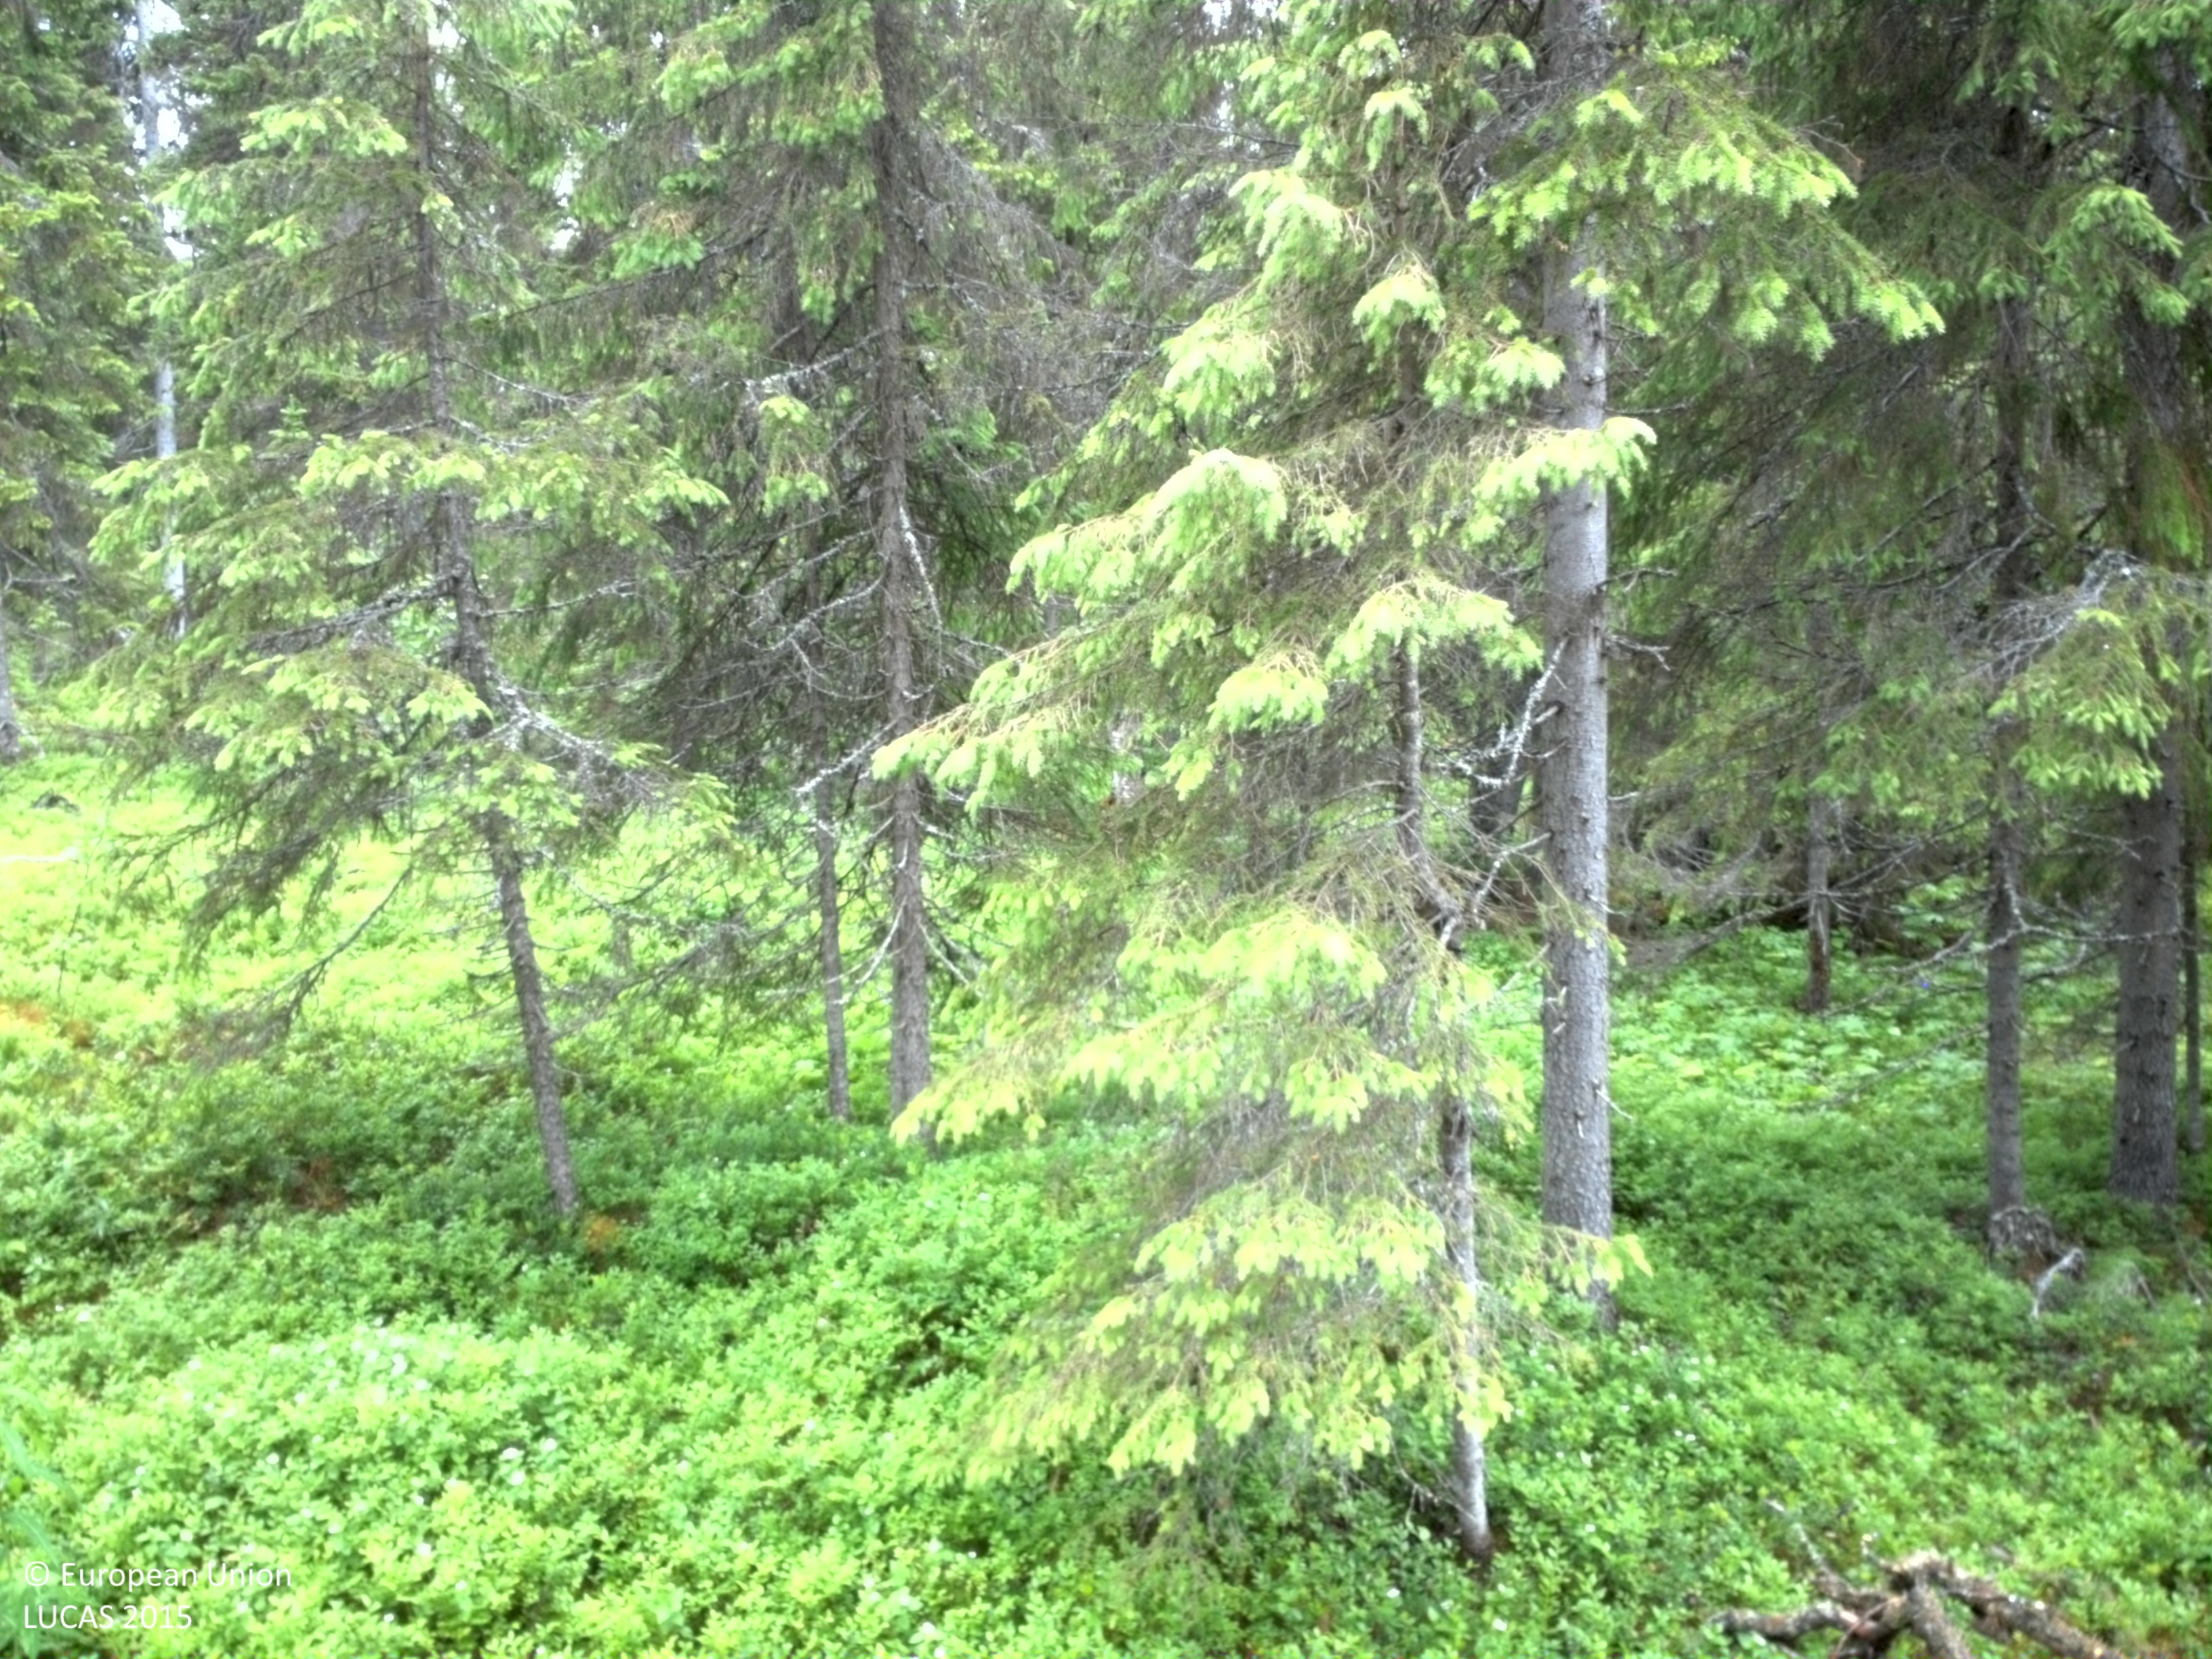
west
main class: Woodland
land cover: Spruce dominated coniferous woodland
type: boreal forest
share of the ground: 25 - 50 %
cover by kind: shrubs 45 %, coniferous forest trees 40 %, lichens and mosses 10 %, herbaceous plants 5 %
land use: Forestry
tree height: > 5 m
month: July
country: SE
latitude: 65.5128
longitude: 15.6075
